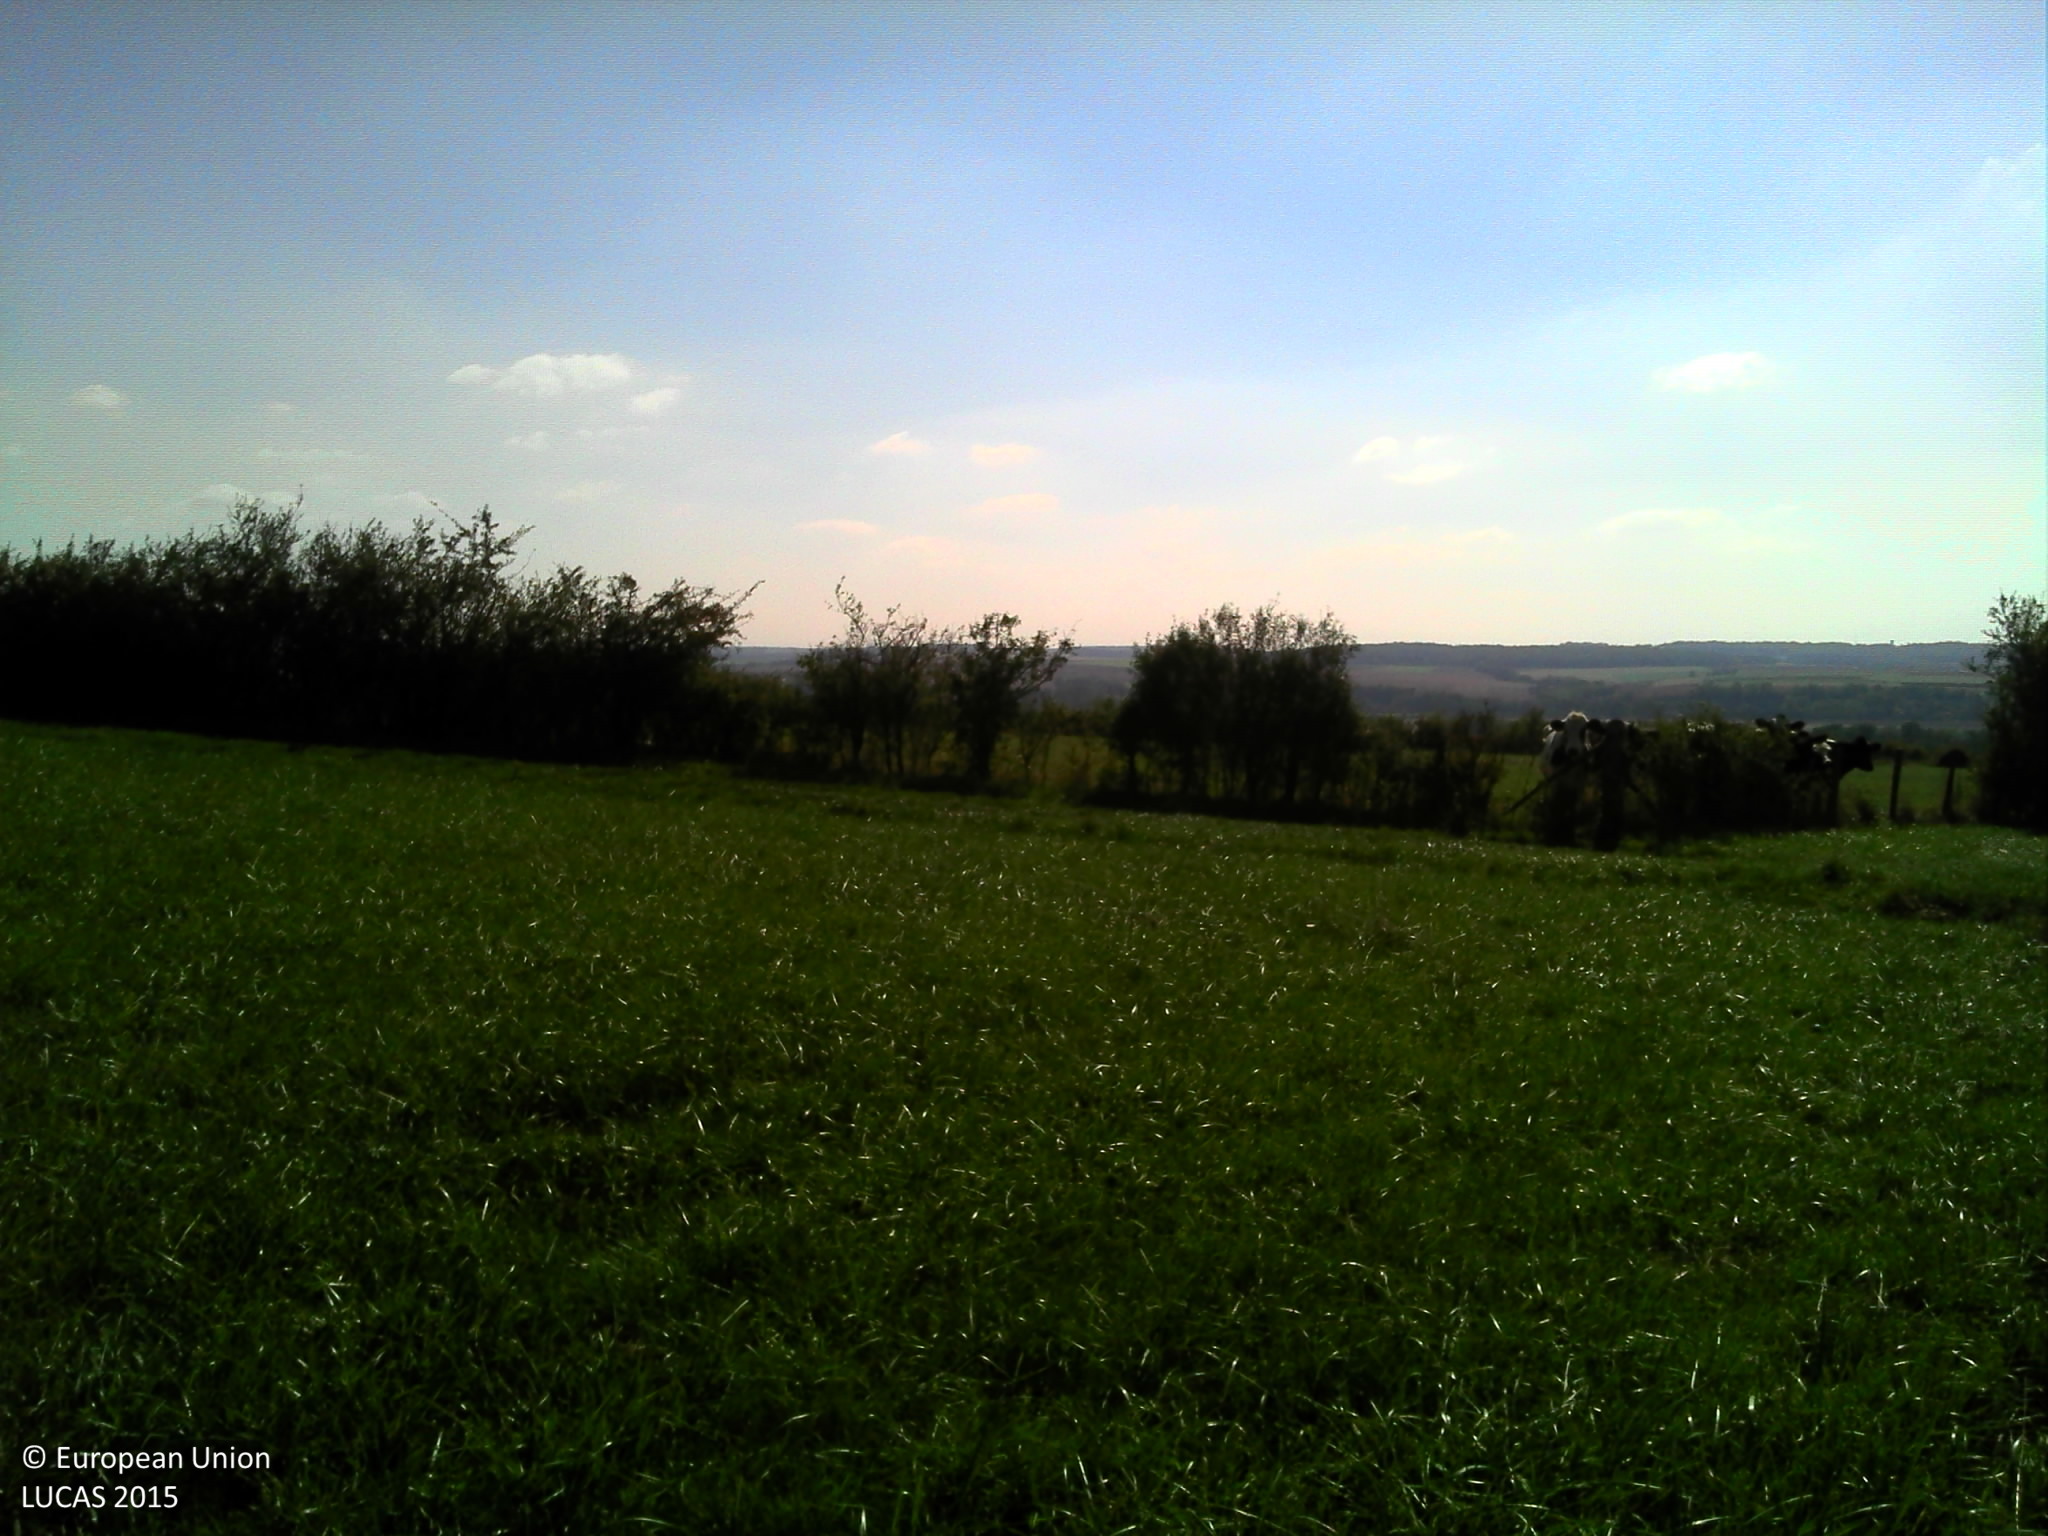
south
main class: Grassland
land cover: Grassland without tree/shrub cover
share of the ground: > 75 %
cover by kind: herbaceous plants 100 %
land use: Agriculture (excluding fallow land and kitchen gardens)
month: October
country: FR
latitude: 47.9466
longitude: 3.9046
